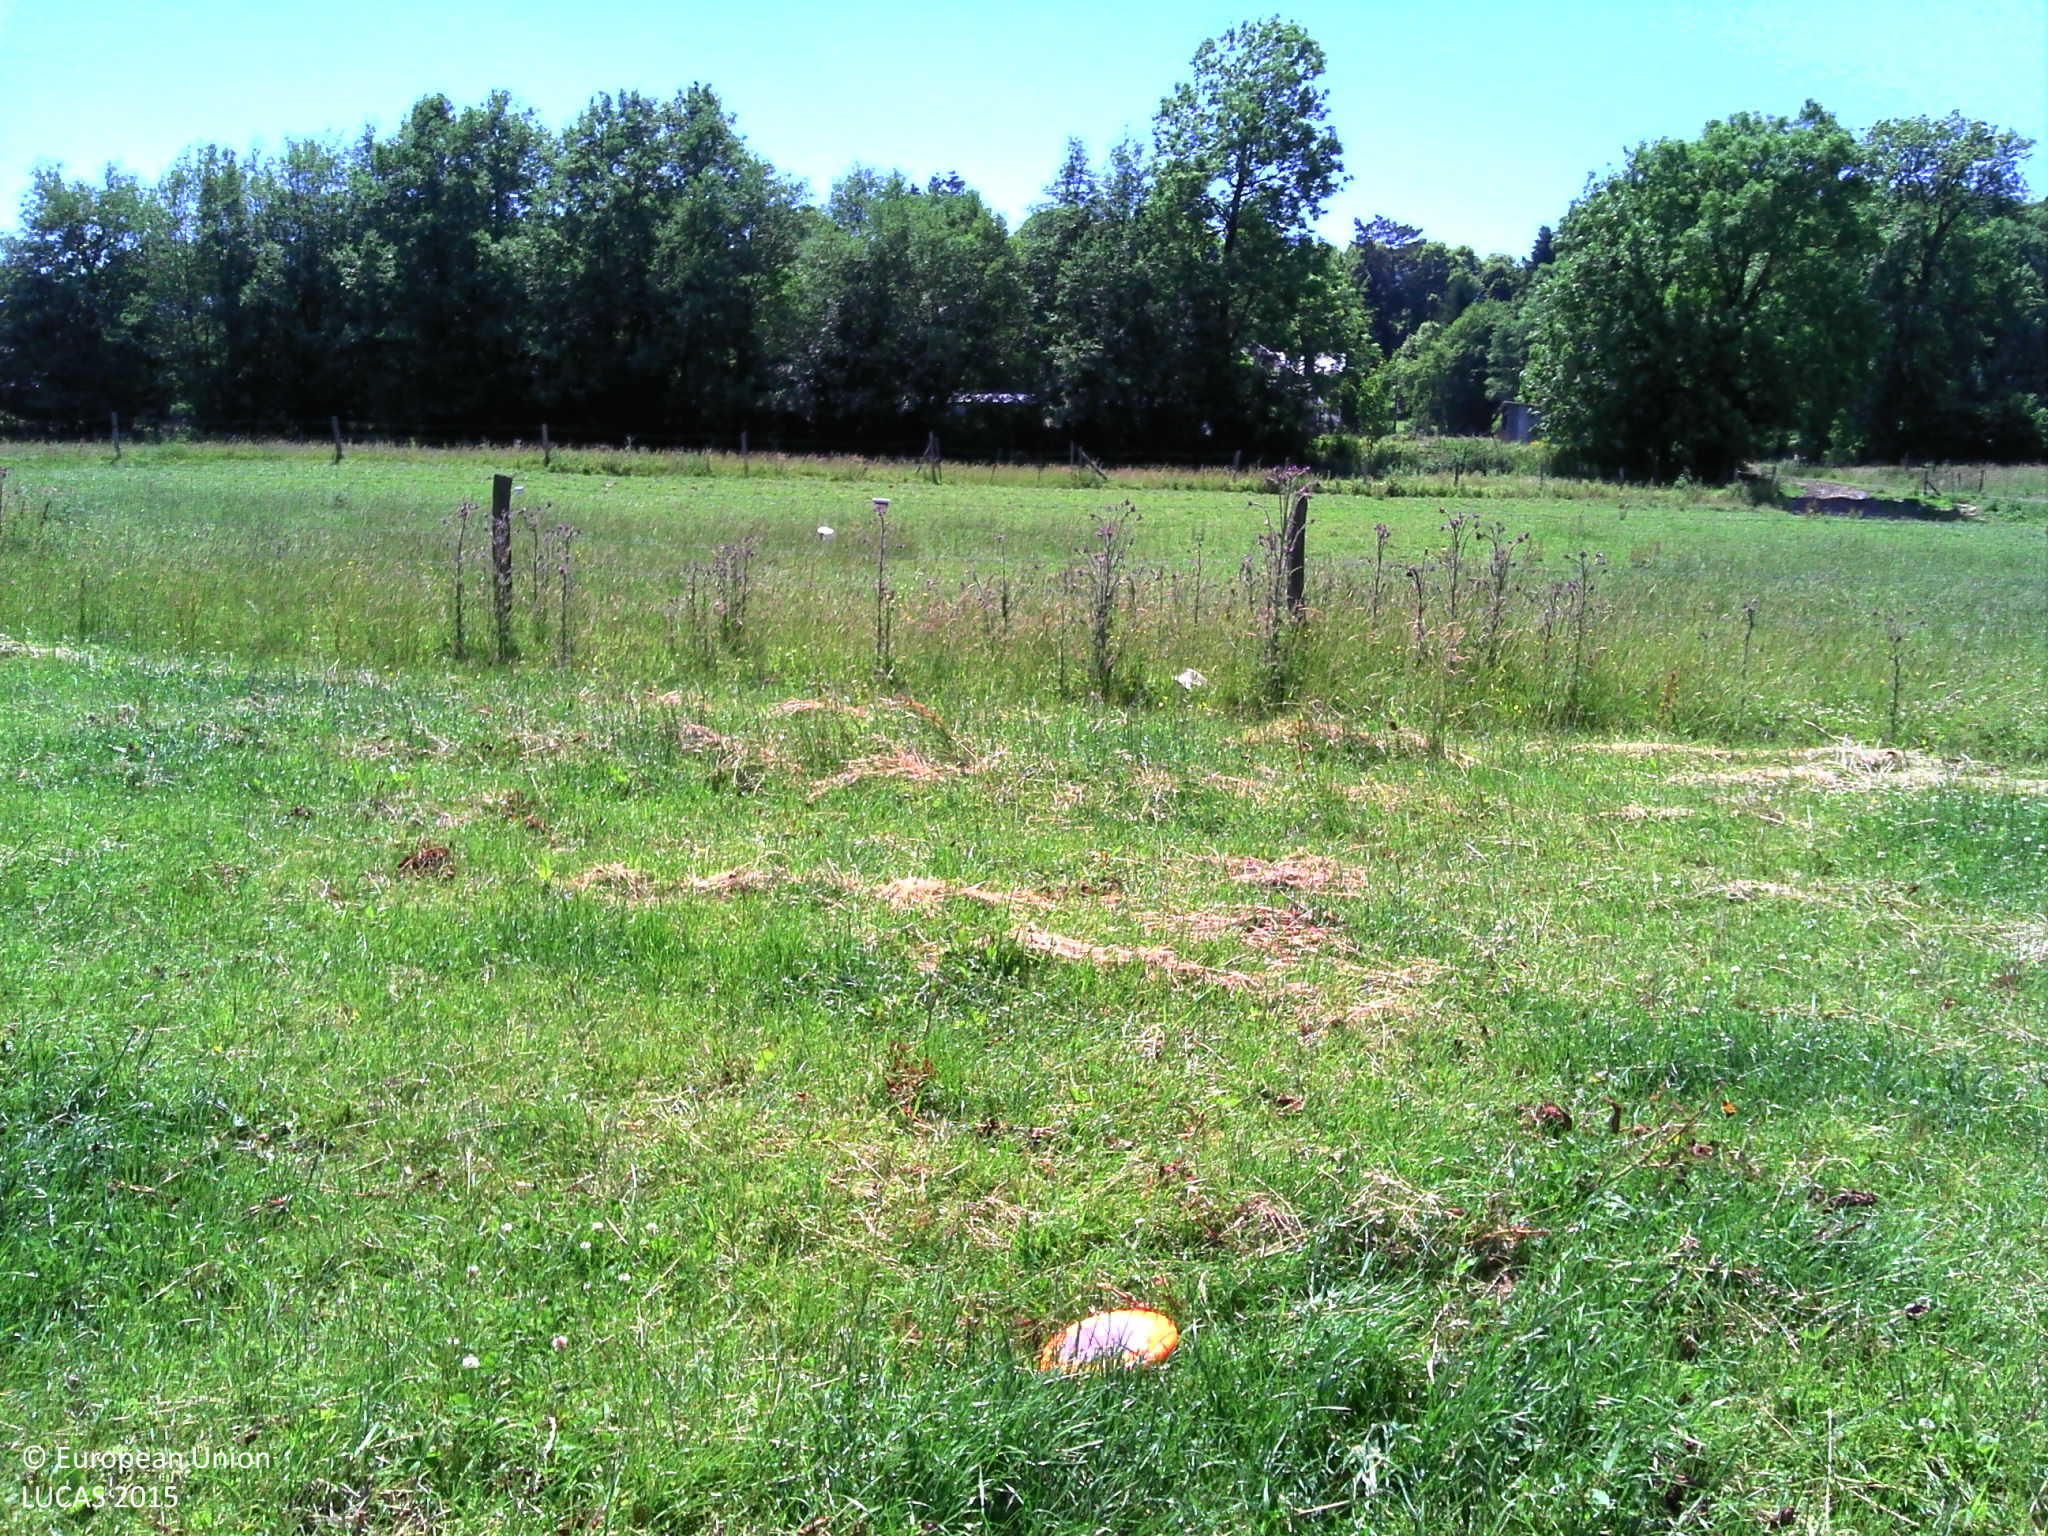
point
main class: Grassland
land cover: Grassland without tree/shrub cover
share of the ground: > 75 %
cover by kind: herbaceous plants 100 %
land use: Agriculture (excluding fallow land and kitchen gardens)
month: June
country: BE
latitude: 50.0421
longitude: 5.5161
